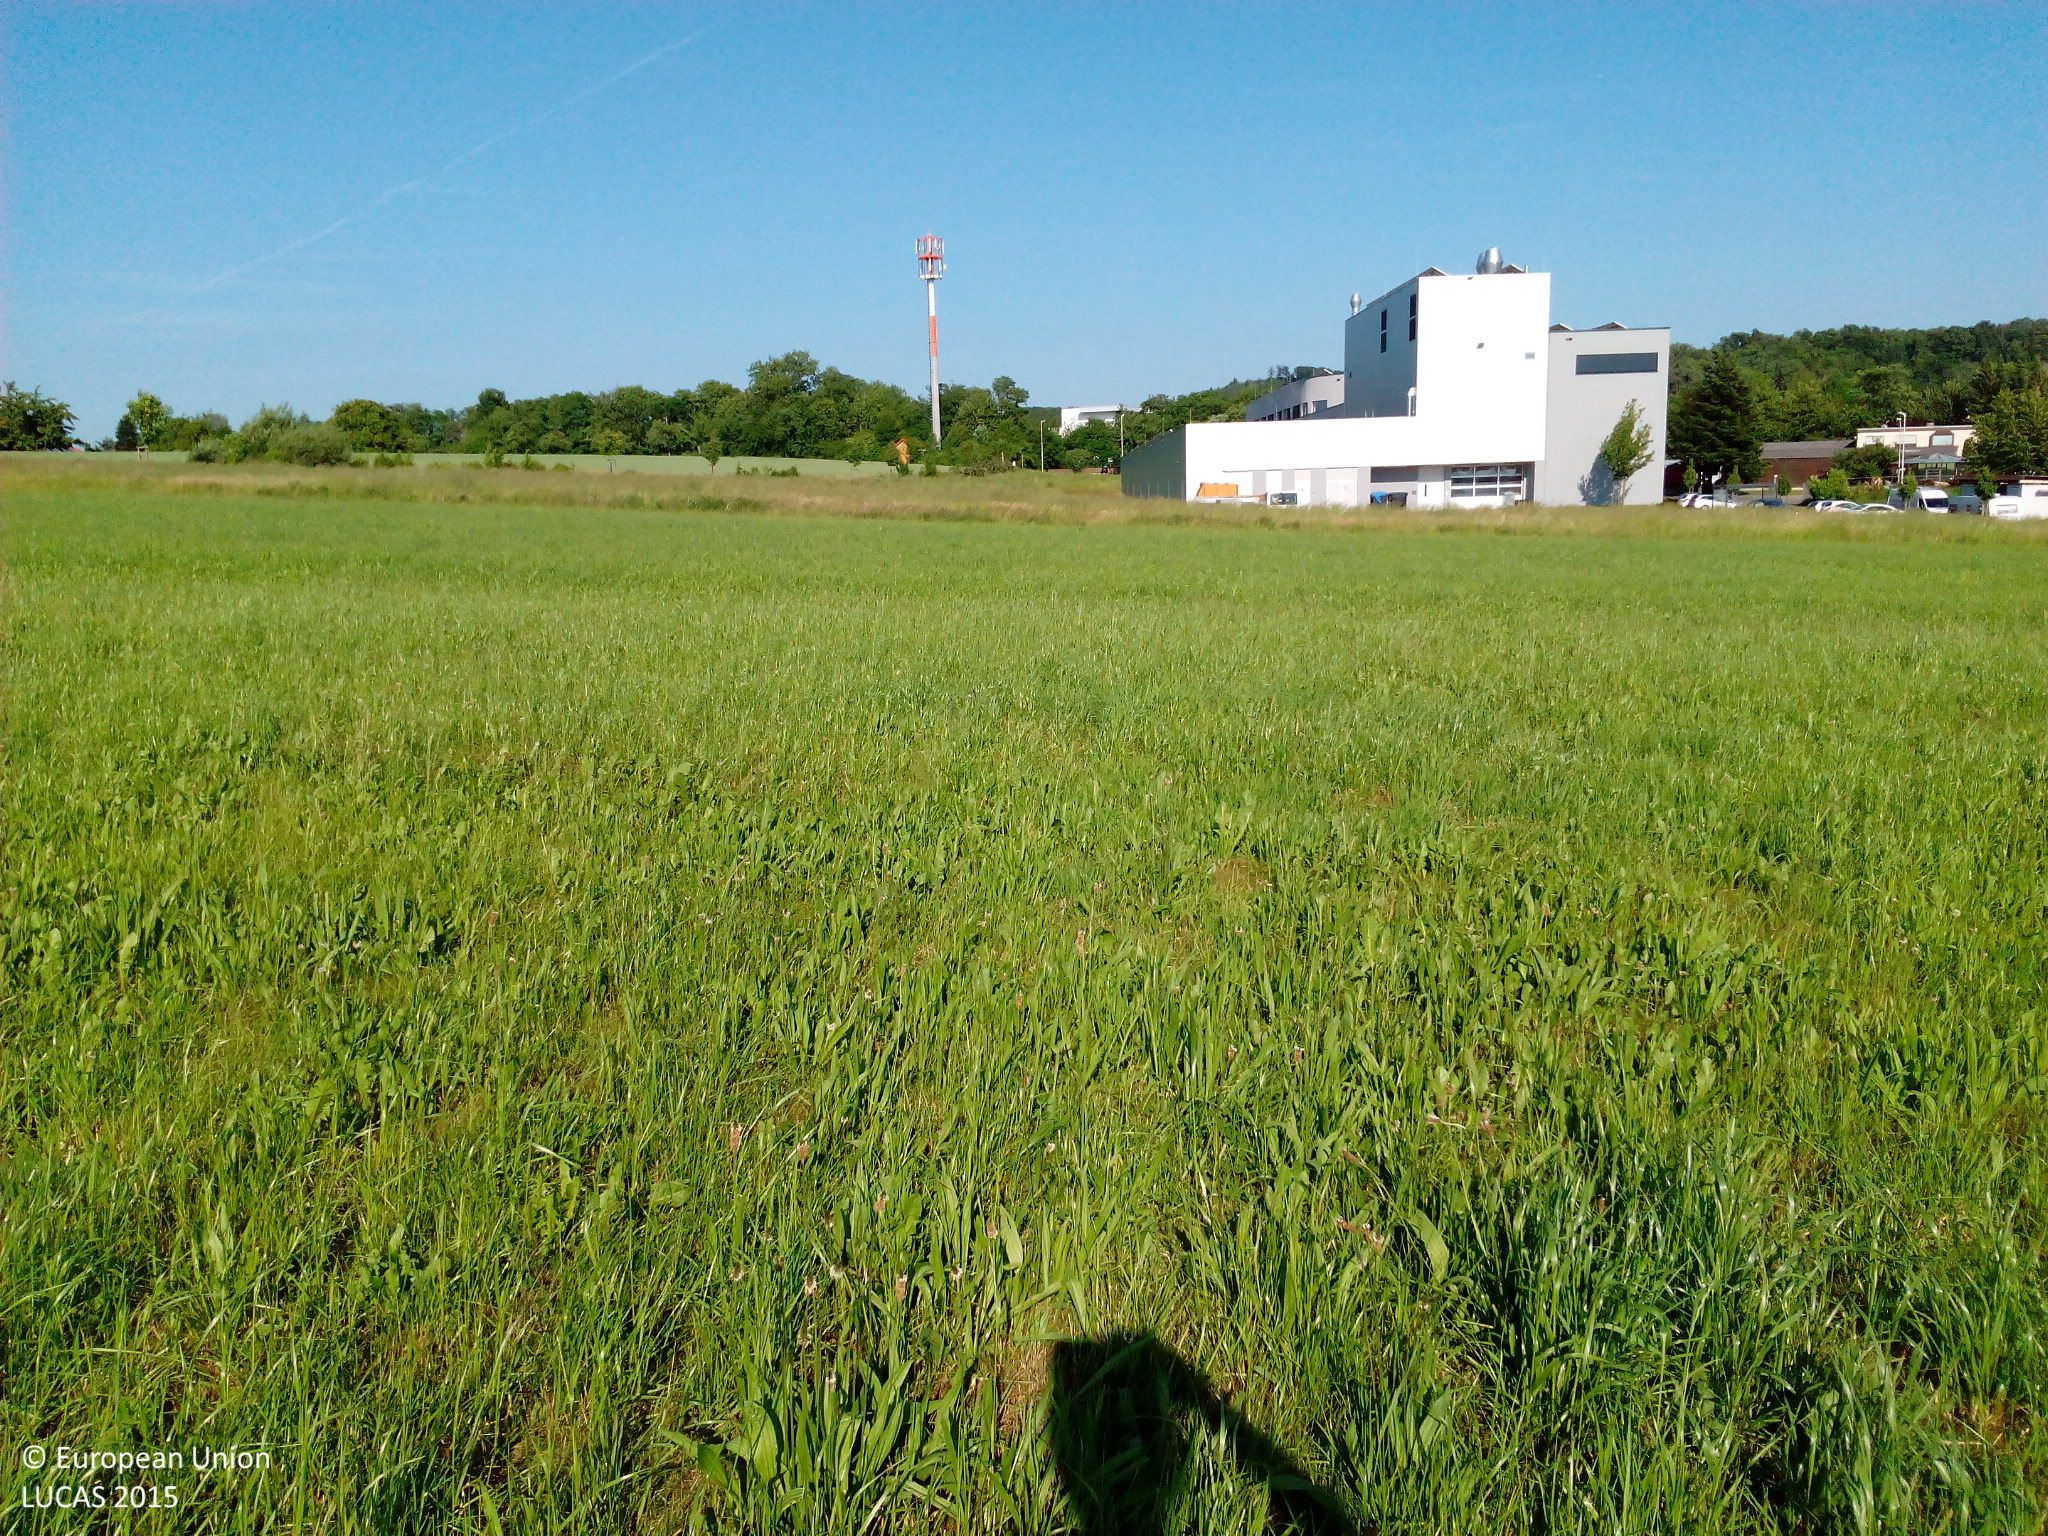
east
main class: Grassland
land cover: Grassland without tree/shrub cover
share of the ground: > 75 %
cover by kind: herbaceous plants 100 %
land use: Agriculture (excluding fallow land and kitchen gardens)
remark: Harvested field
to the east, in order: Grassland without tree/shrub cover; Spontaneously vegetated surfaces; Paved roads, cycling and walking lanes
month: June
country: DE
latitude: 48.9057
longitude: 9.4136
